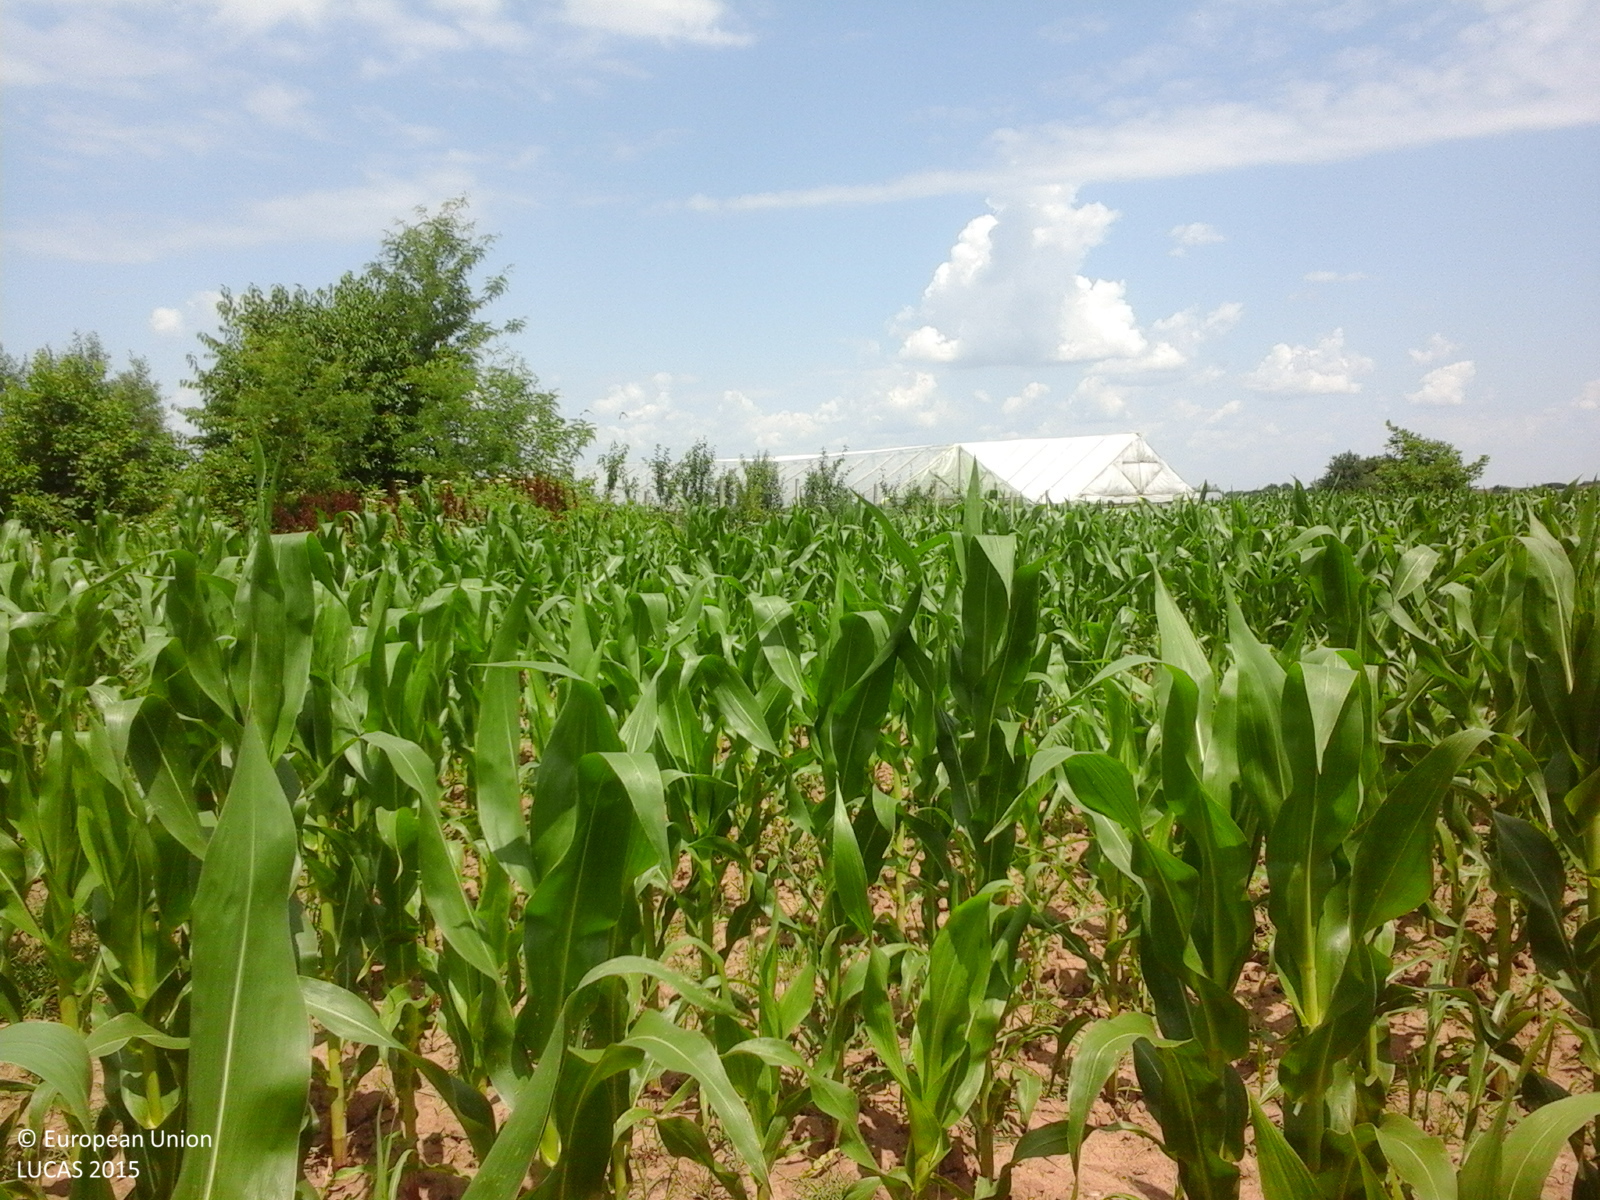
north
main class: Cropland
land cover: Maize
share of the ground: > 75 %
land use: Agriculture (excluding fallow land and kitchen gardens)
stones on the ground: < 10 %
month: June
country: RO
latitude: 44.2142
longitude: 26.2649
